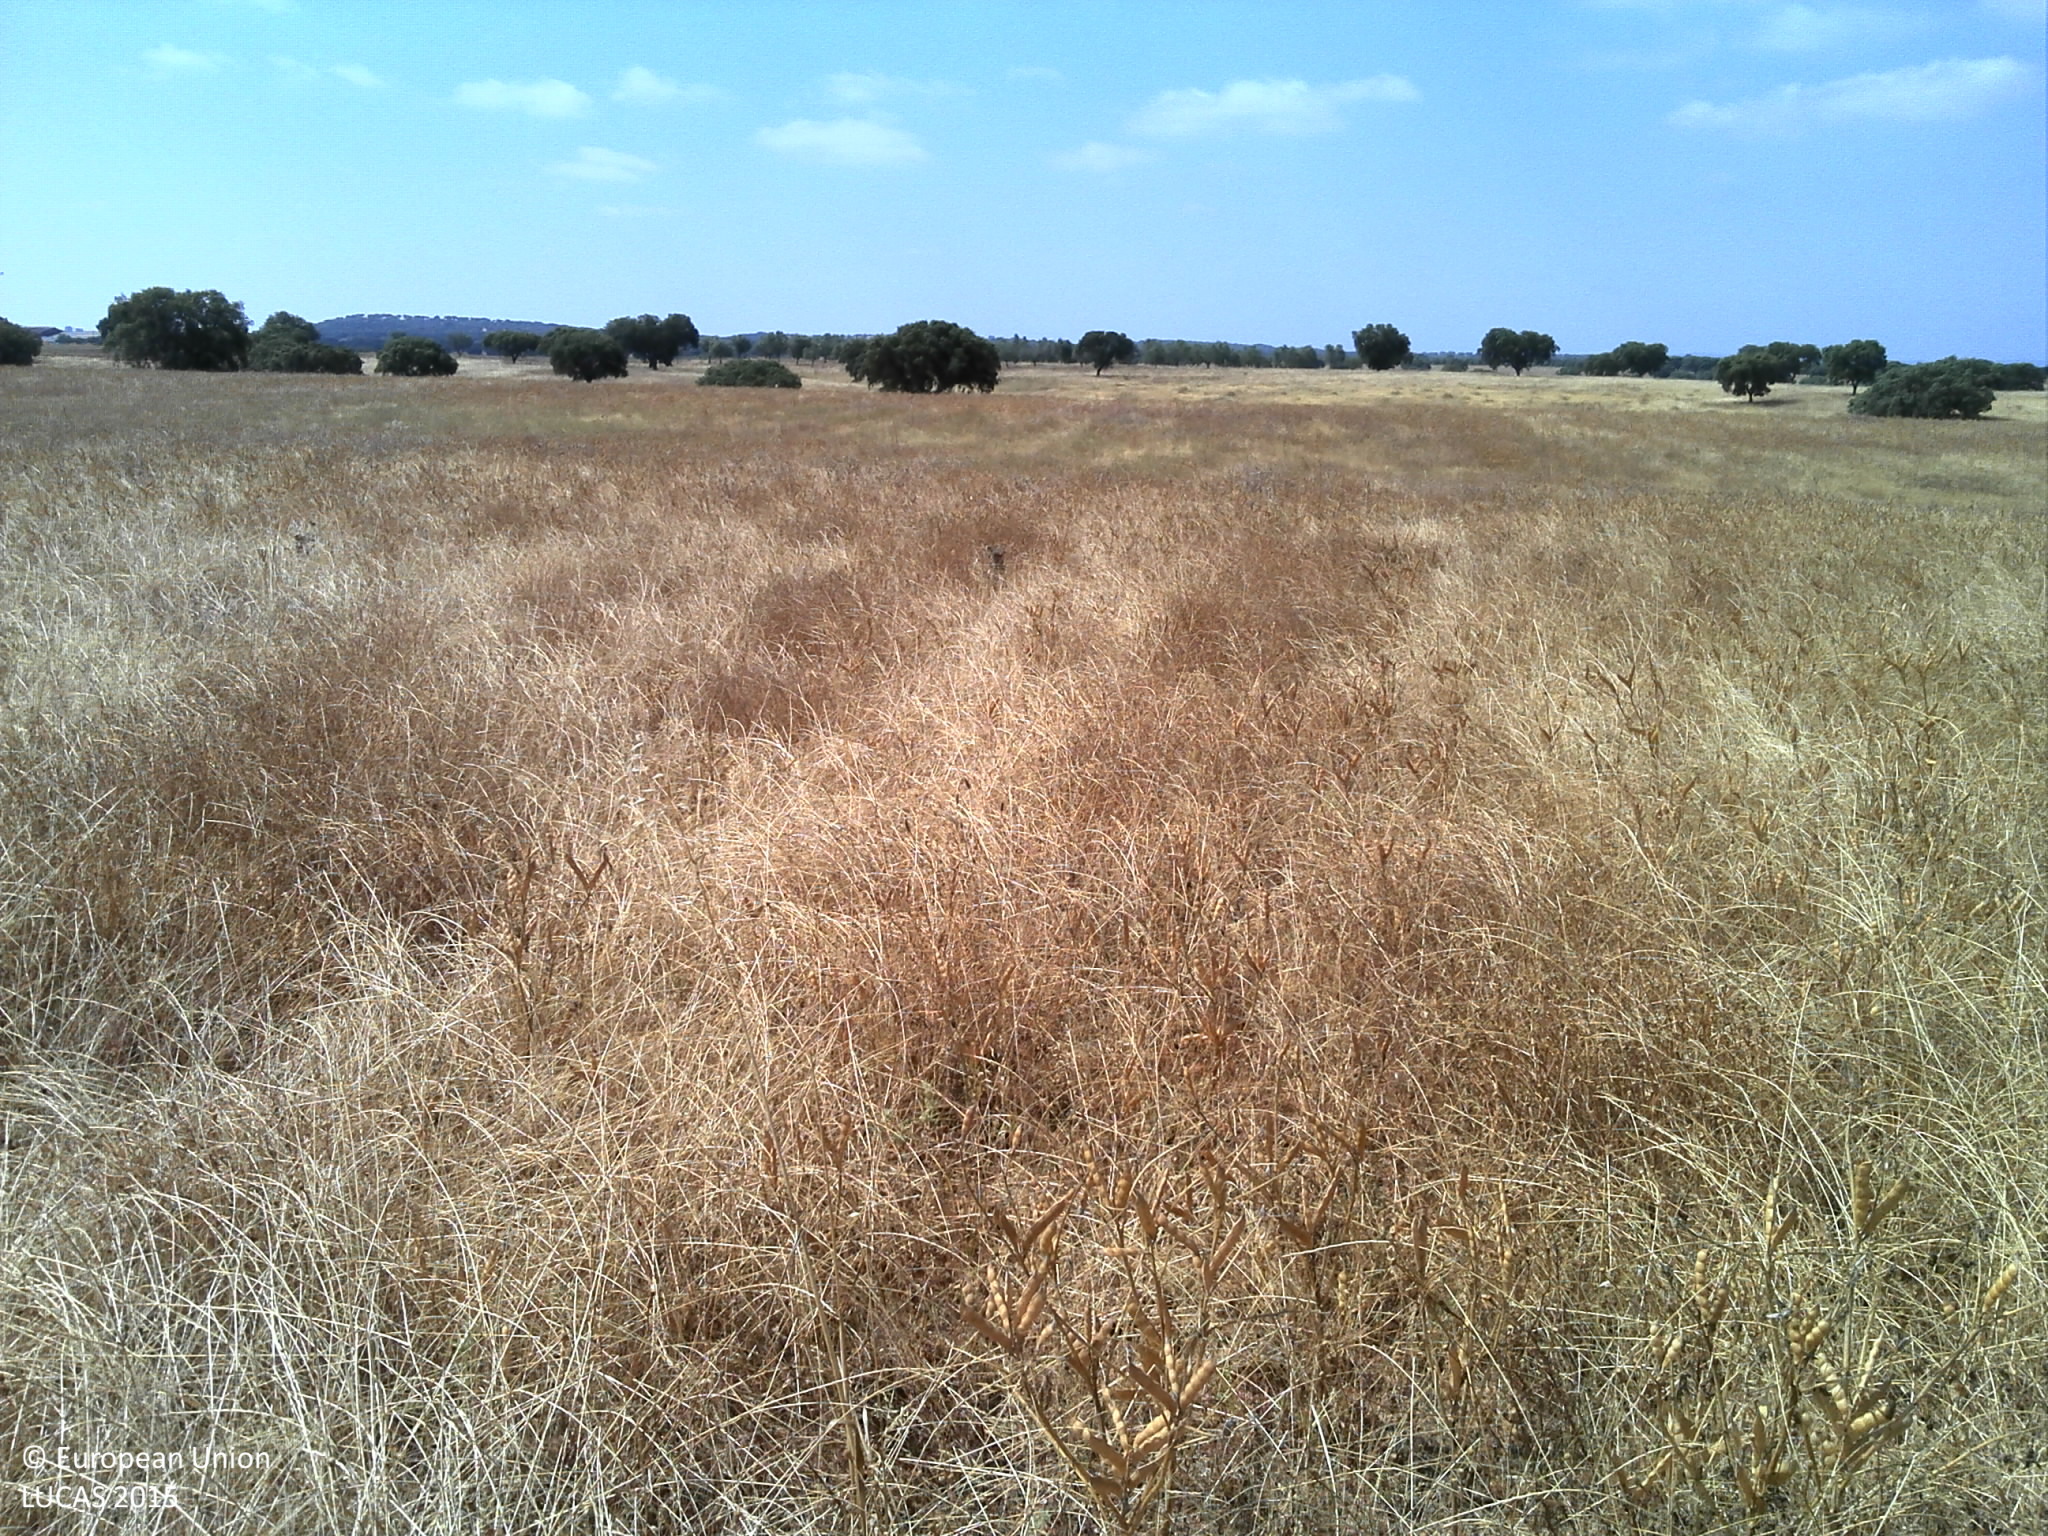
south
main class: Grassland
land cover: Grassland without tree/shrub cover
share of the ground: > 75 %
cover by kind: herbaceous plants 90 %, unconsolidated bare surface 10 %
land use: Agriculture (excluding fallow land and kitchen gardens)
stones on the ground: < 10 %
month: June
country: PT
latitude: 37.8410
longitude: -8.3189
